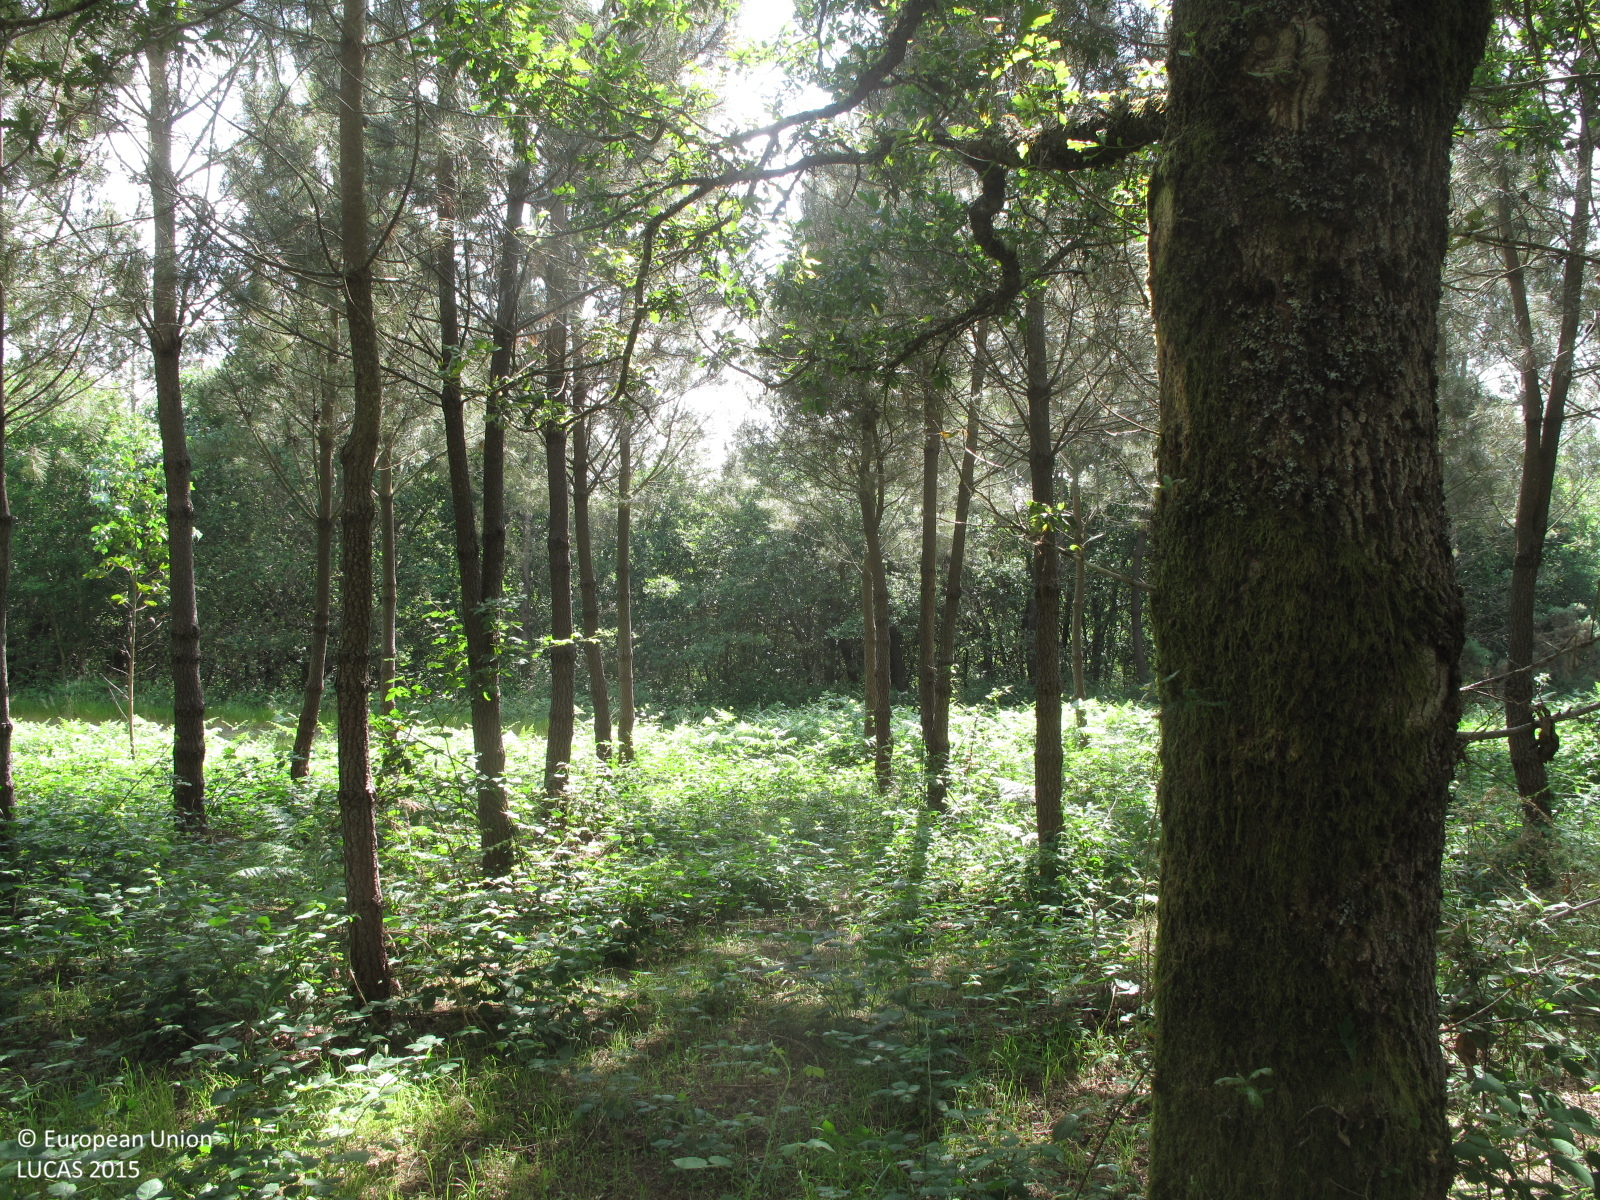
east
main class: Woodland
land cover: Other mixed woodland
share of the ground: > 75 %
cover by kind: coniferous forest trees 50 %, broadleaved forest trees 40 %, shrubs 10 %
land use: Forestry
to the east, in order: Other mixed woodland; Tracks; Other mixed woodland; Tracks; Grassland without tree/shrub cover
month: June
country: ES
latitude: 42.9809
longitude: -8.5118
